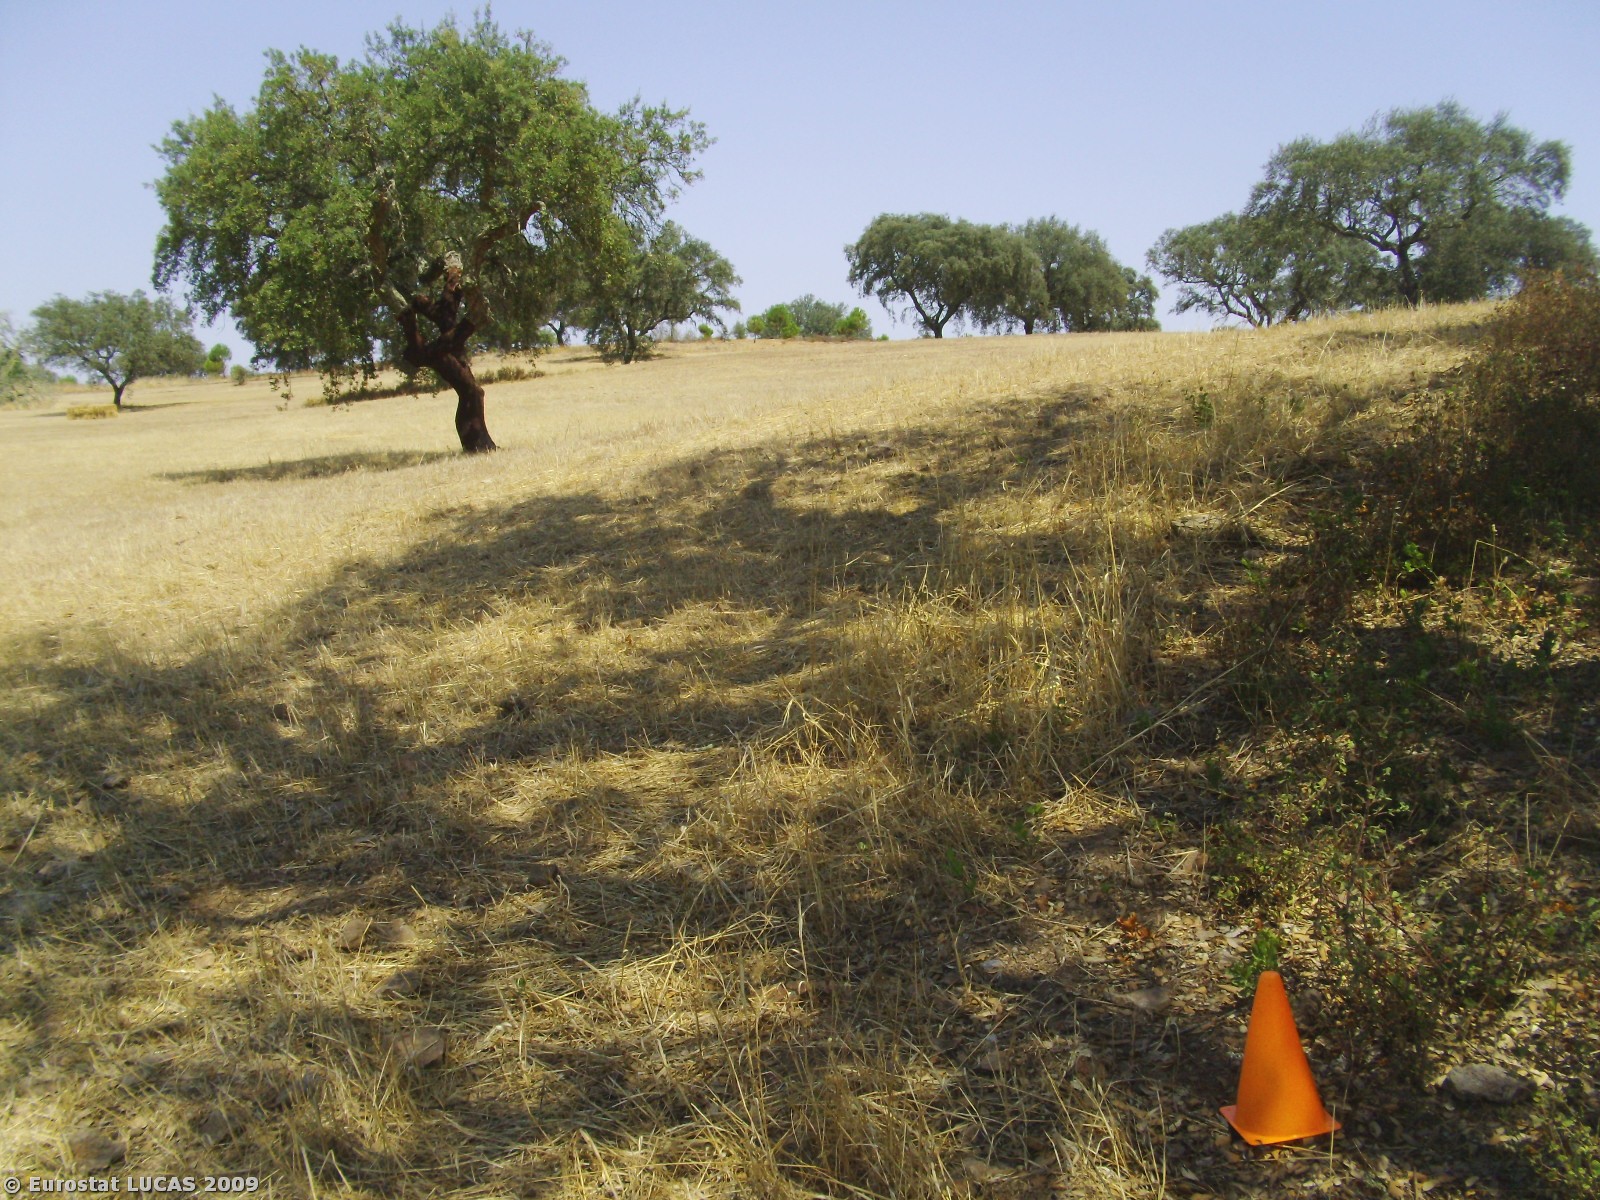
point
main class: Woodland
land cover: Broadleaved woodland
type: broadleaved evergreen forest
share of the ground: 50 - 75 %
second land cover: Oats
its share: < 10 %
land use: Forestry
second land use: Agriculture (excluding fallow land and kitchen gardens)
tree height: > 5 m
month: August
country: PT
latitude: 38.3864
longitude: -7.7896
